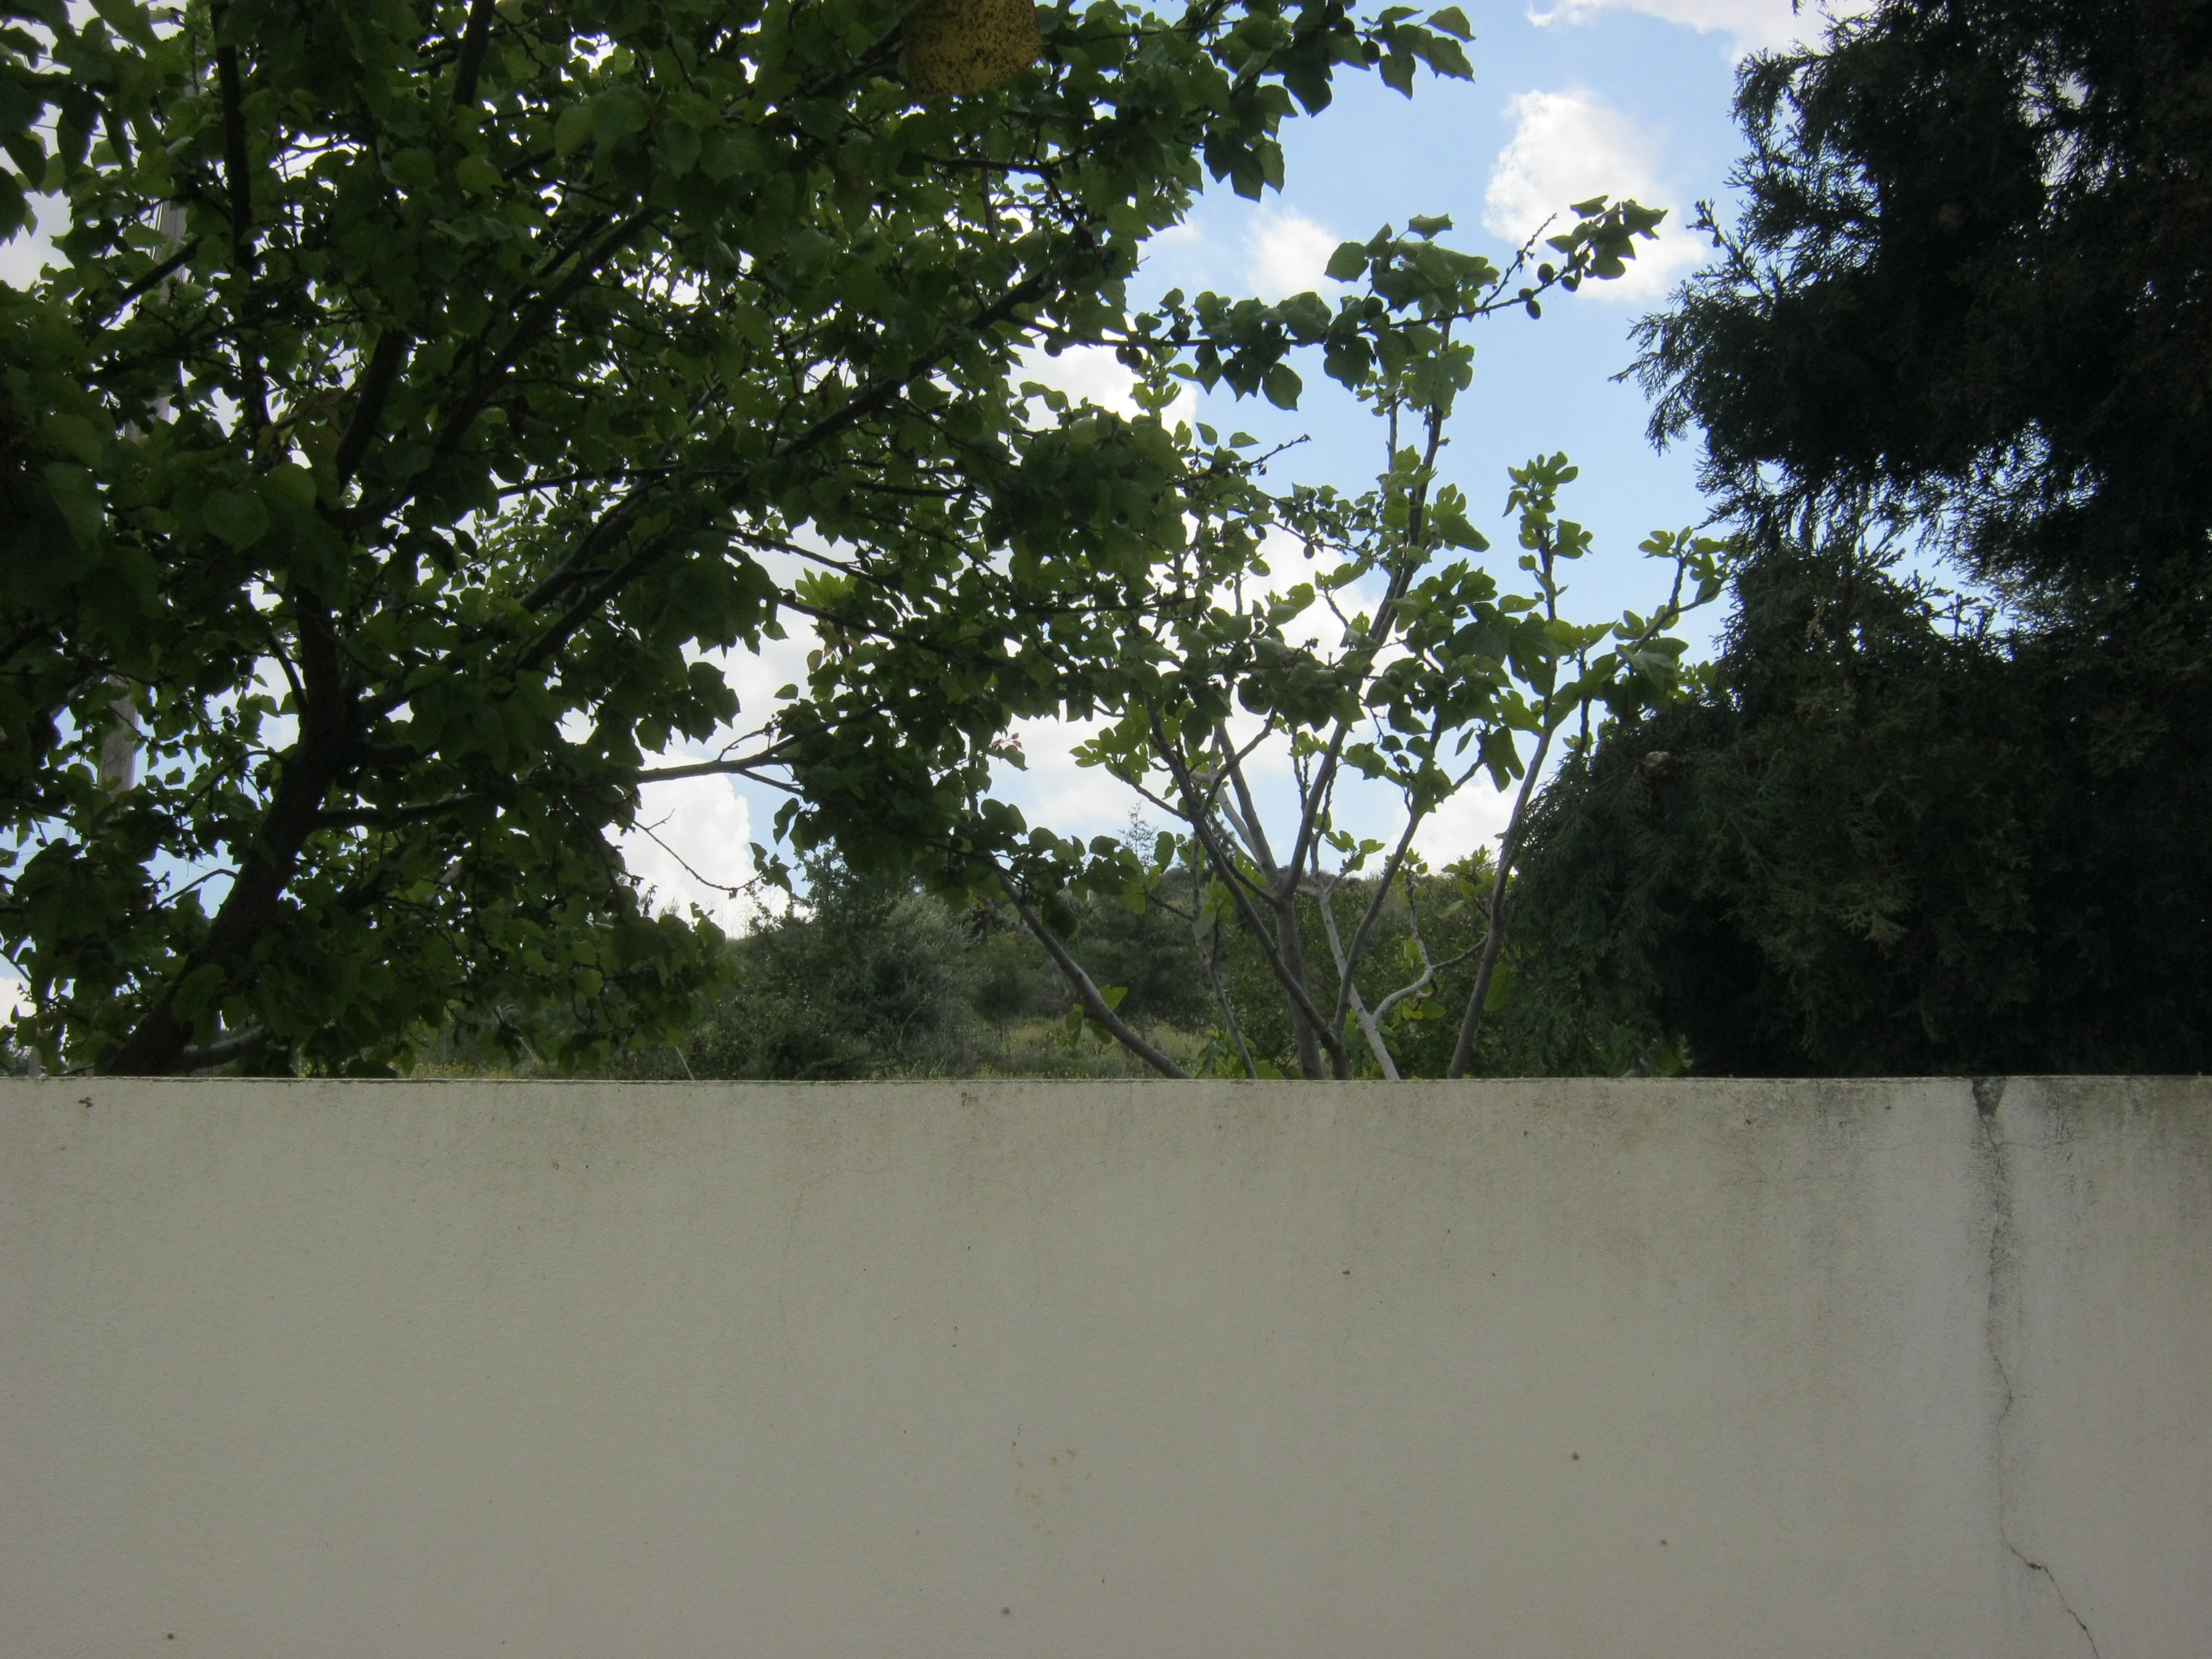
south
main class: Cropland
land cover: Olive groves
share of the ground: < 10 %
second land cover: Spontaneously vegetated surfaces
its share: > 75 %
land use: Kitchen garden
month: April
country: CY
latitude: 34.9836
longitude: 33.3564
